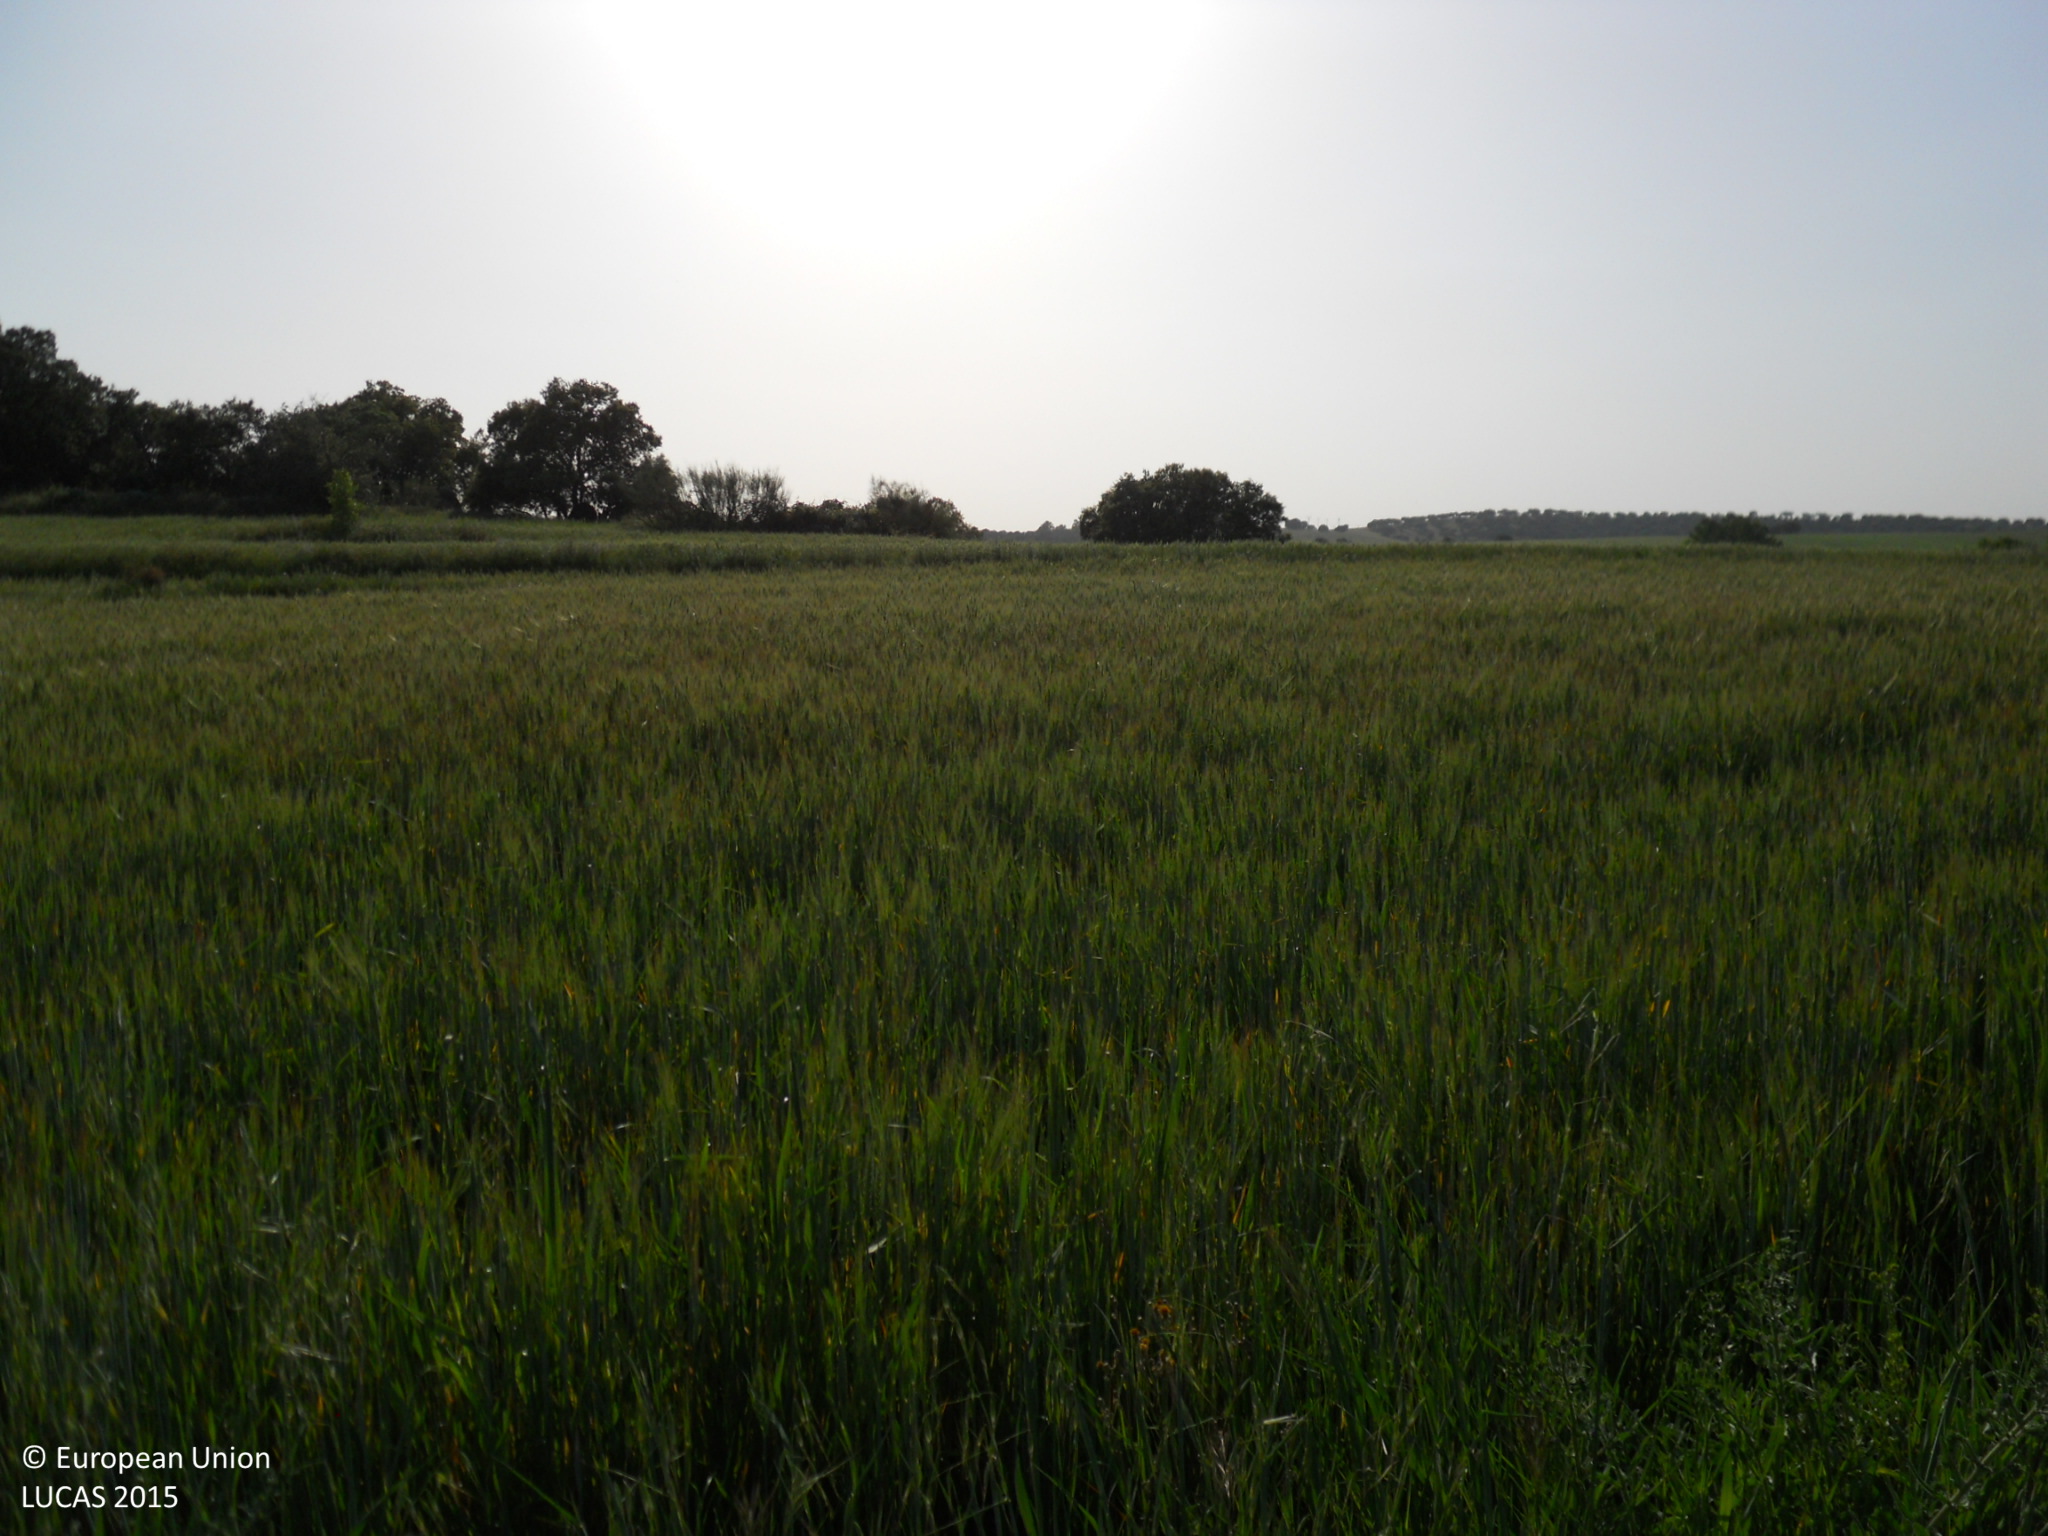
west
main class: Cropland
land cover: Barley
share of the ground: > 75 %
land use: Agriculture (excluding fallow land and kitchen gardens)
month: April
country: ES
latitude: 39.0525
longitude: -6.3414
